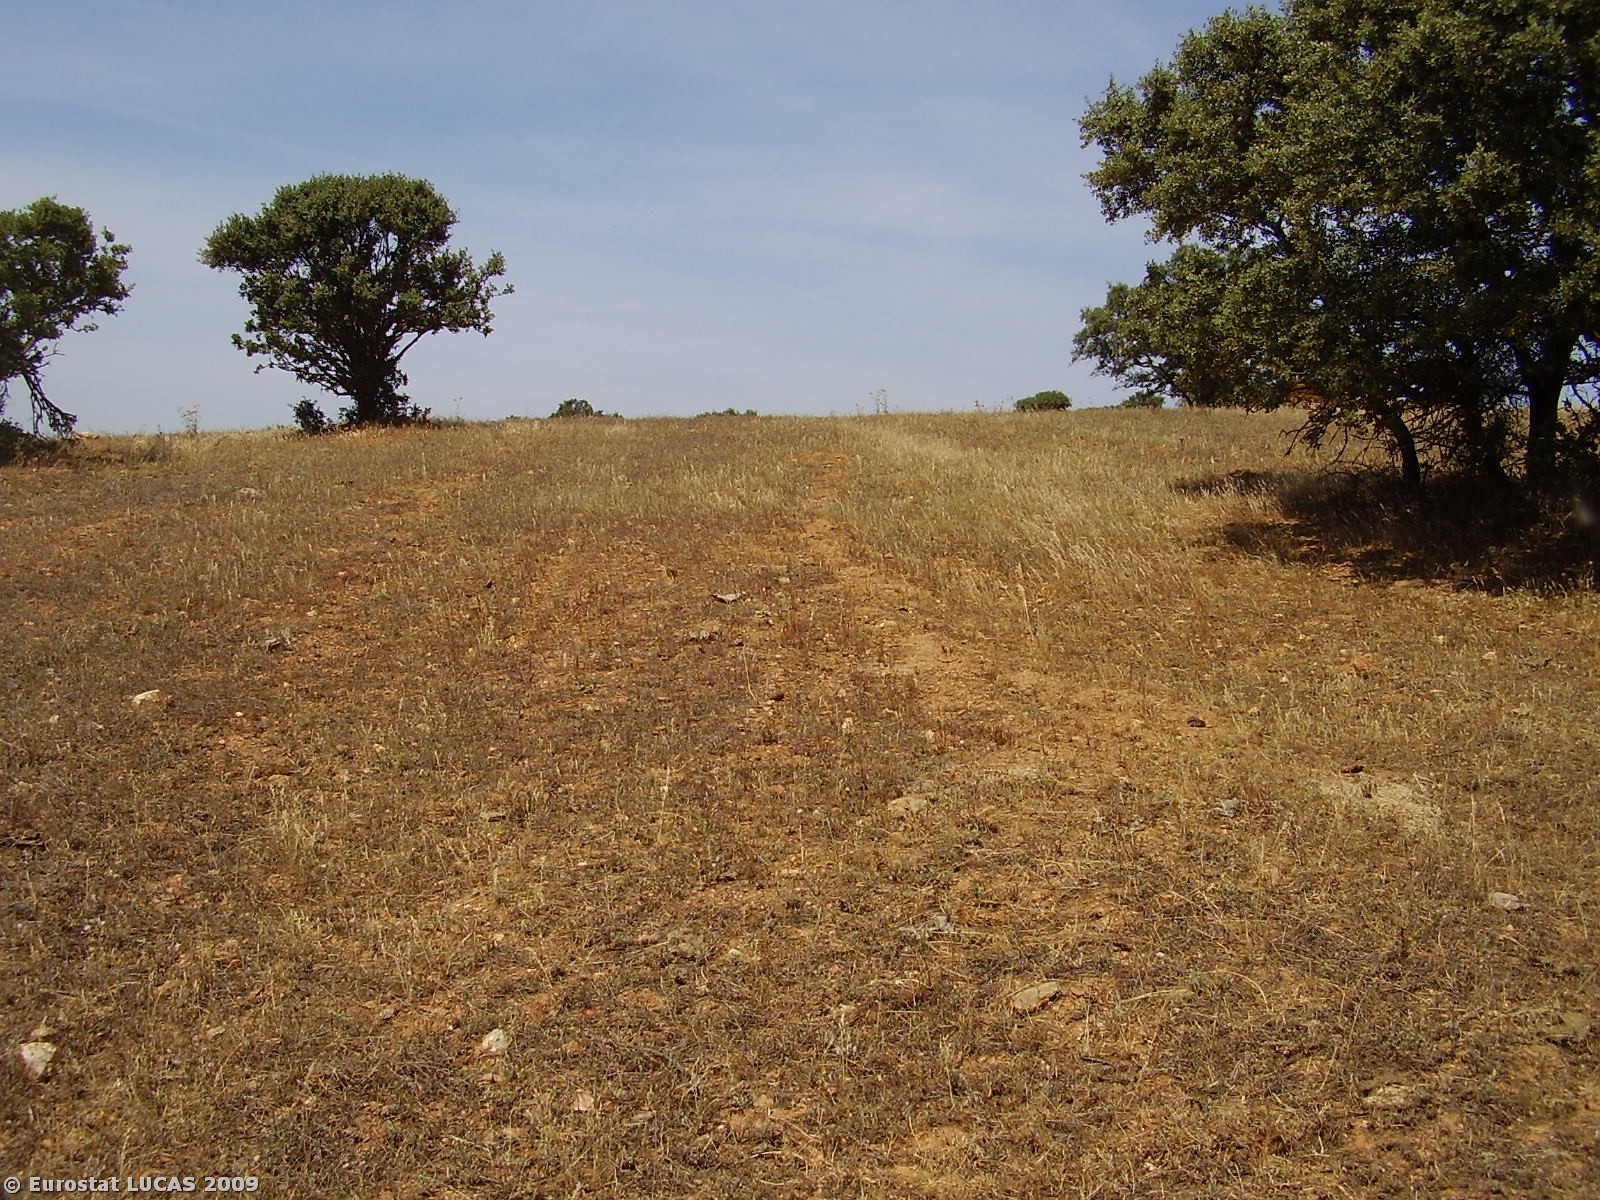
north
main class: Grassland
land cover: Grassland with sparse tree/shrub cover
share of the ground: 50 - 75 %
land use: Agriculture (excluding fallow land and kitchen gardens)
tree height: > 5 m
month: May
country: PT
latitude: 37.7383
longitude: -7.5008
